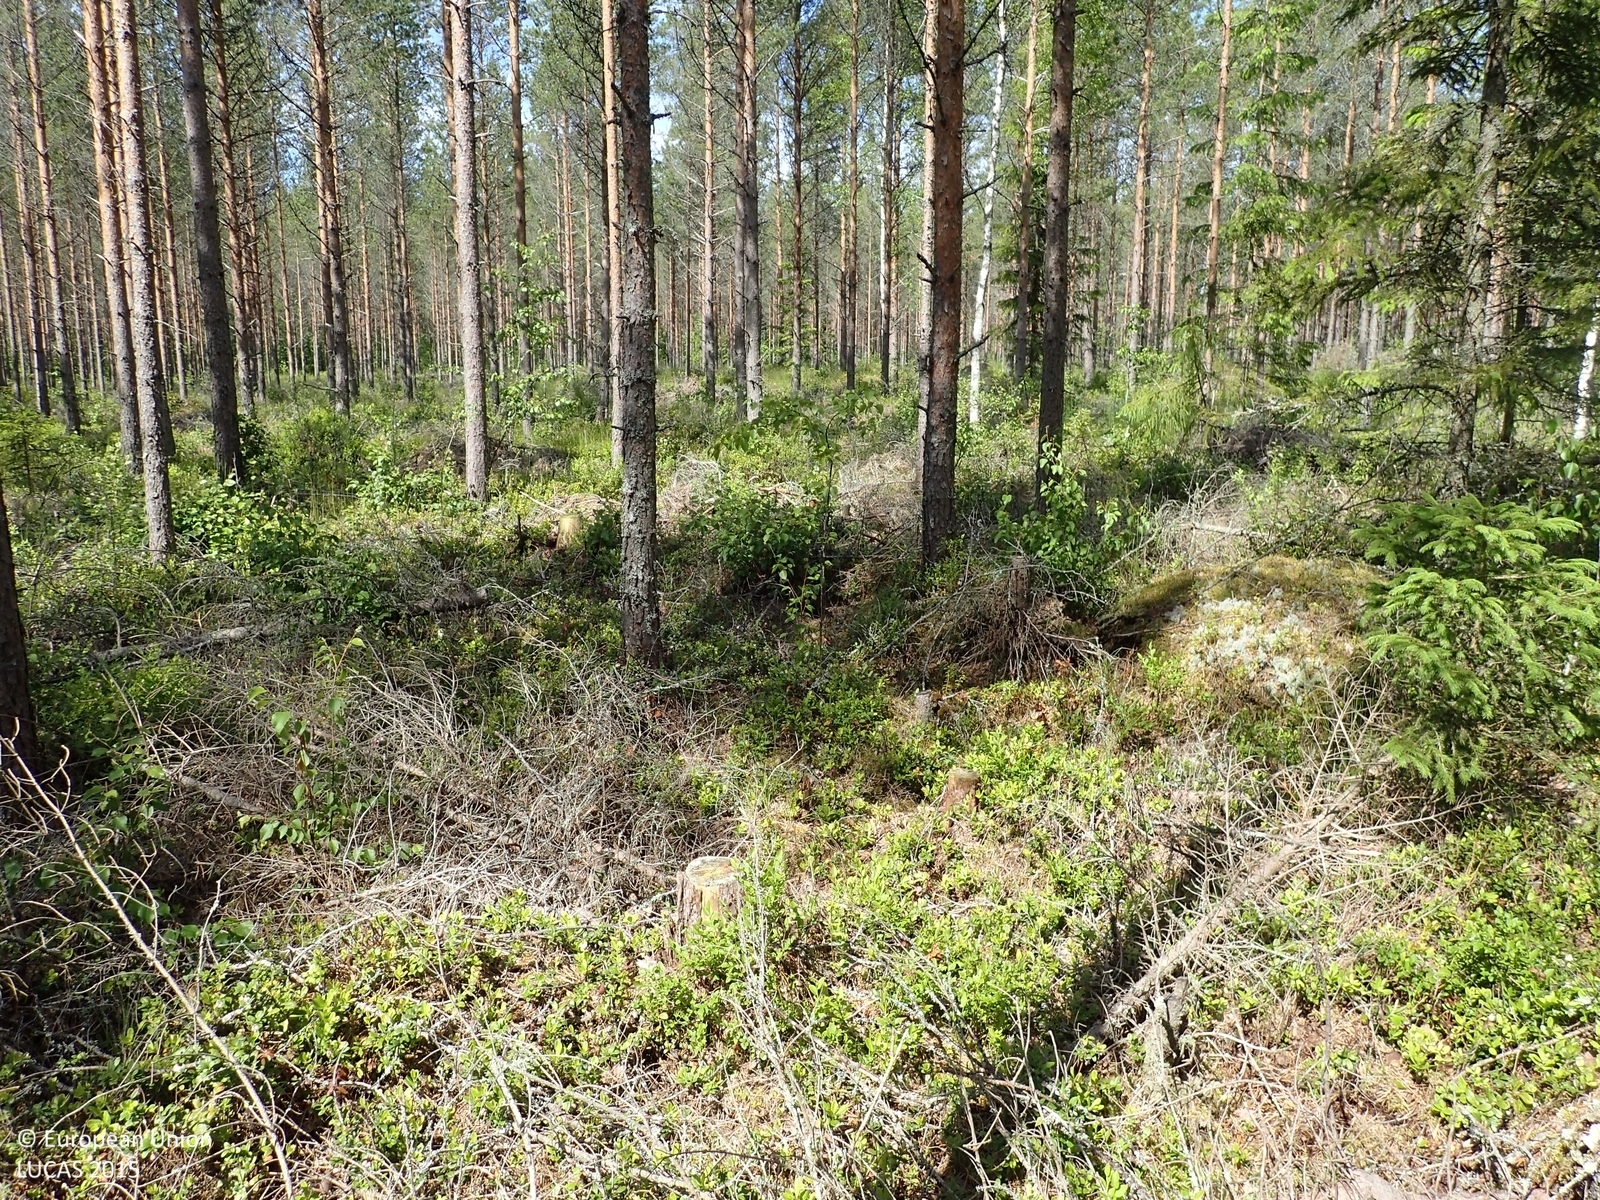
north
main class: Woodland
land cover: Pine dominated coniferous woodland
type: boreal forest
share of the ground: 50 - 75 %
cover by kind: coniferous forest trees 60 %, shrubs 30 %, broadleaved forest trees 5 %, herbaceous plants 5 %
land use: Forestry
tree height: > 5 m
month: June
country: FI
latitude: 62.4179
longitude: 21.6027
